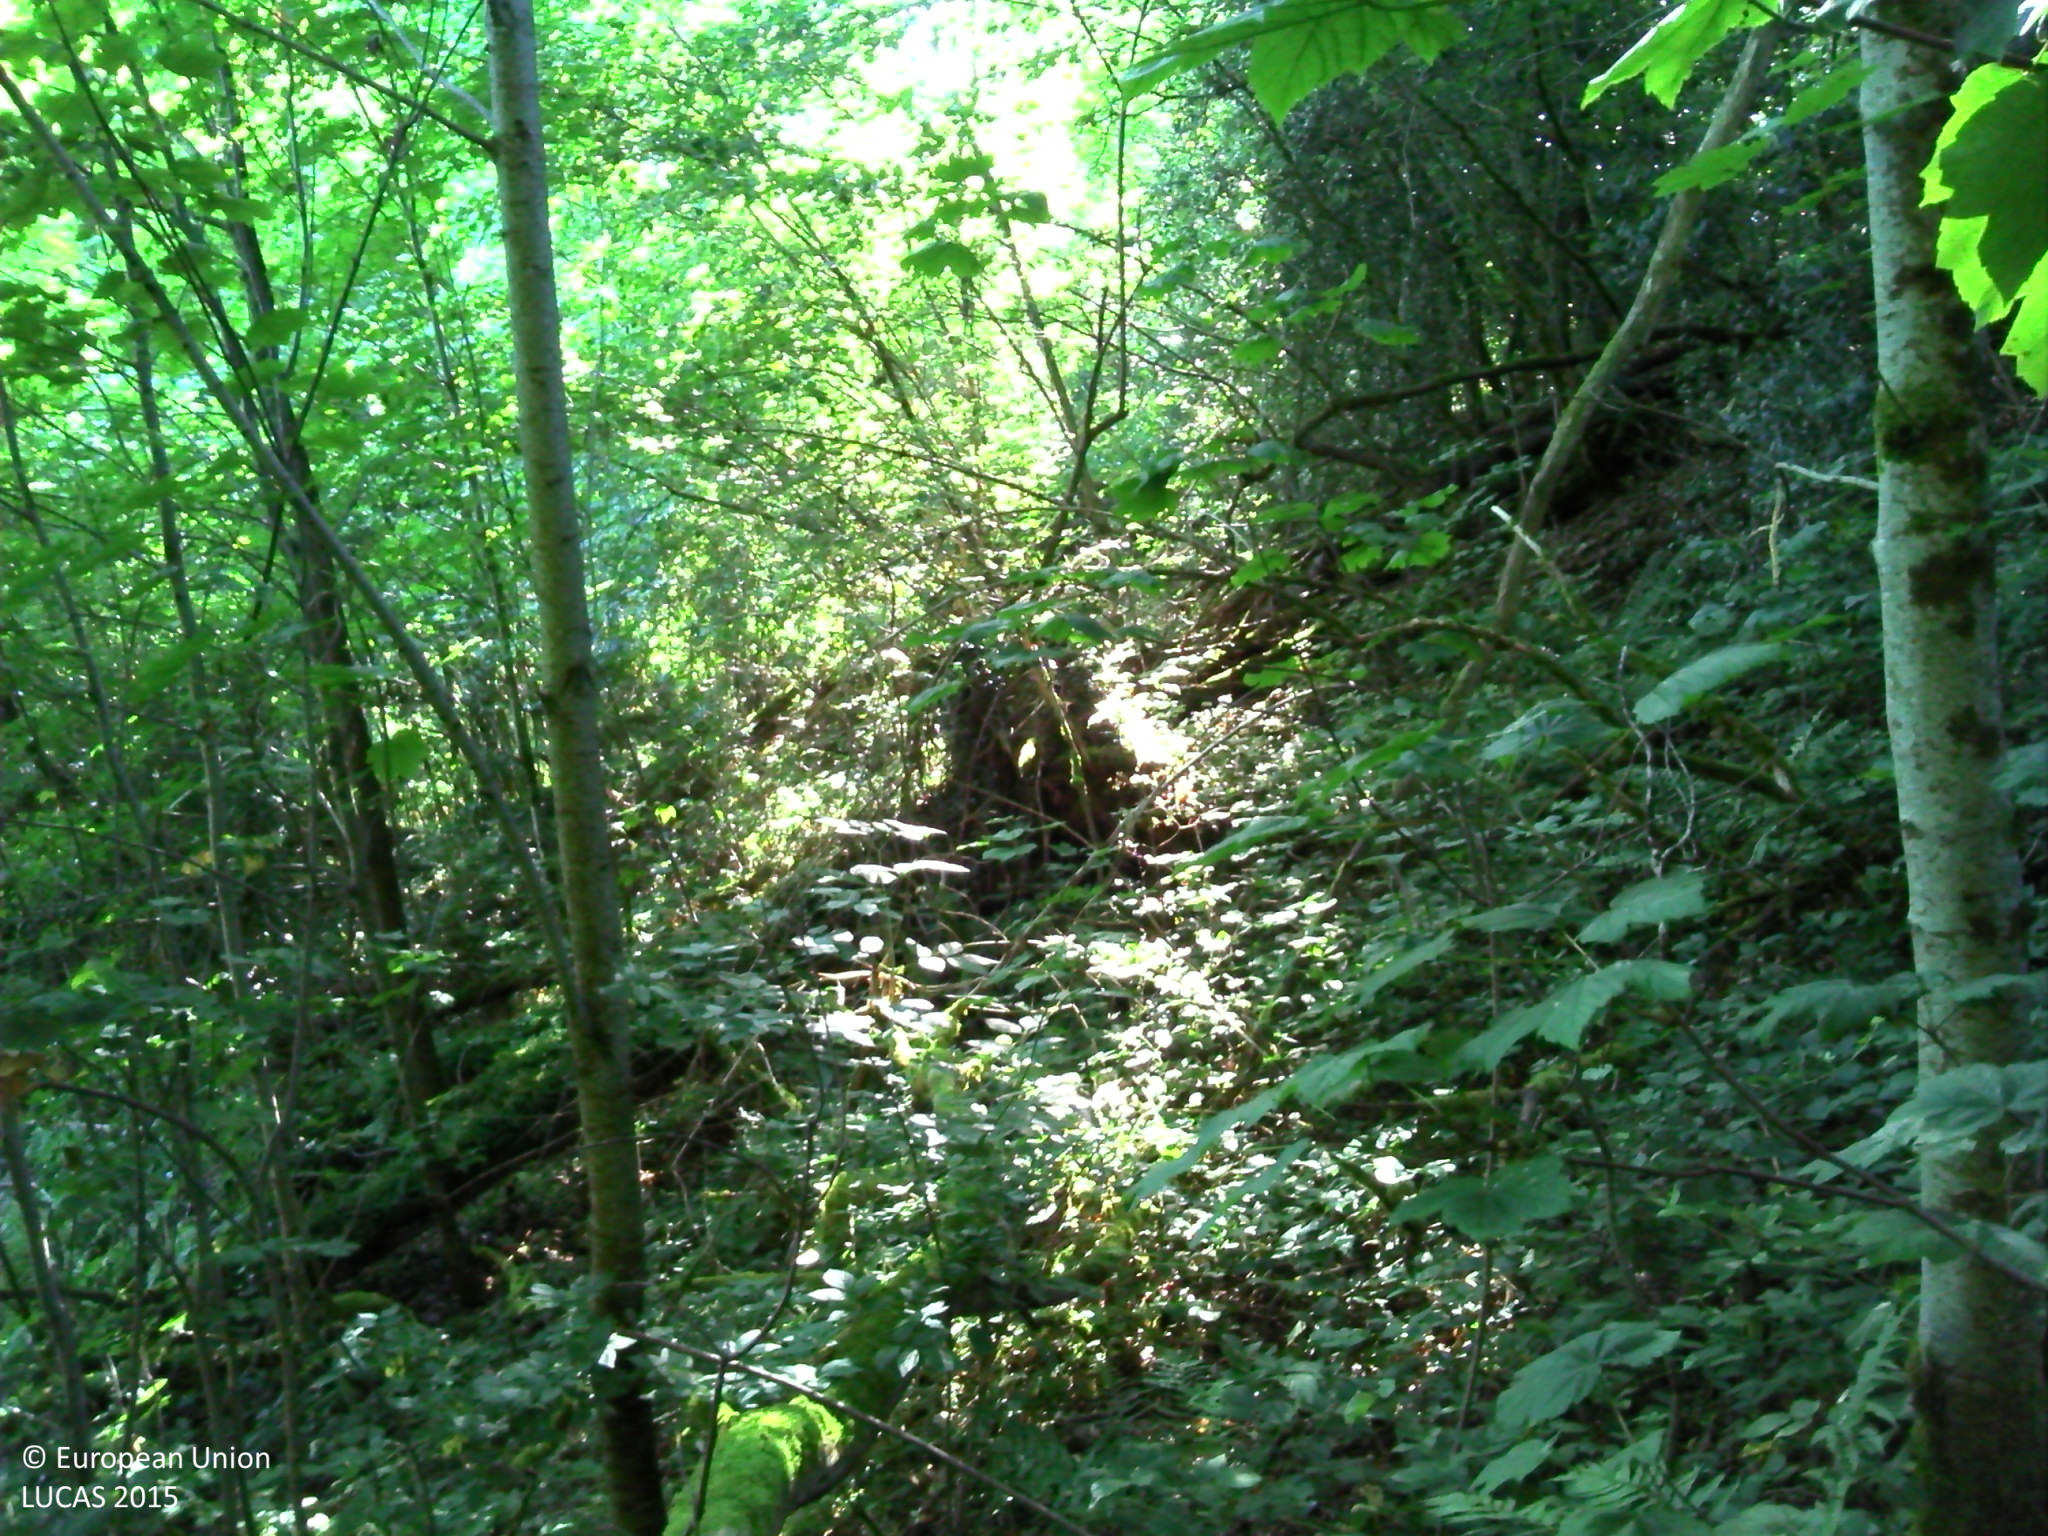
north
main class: Woodland
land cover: Broadleaved woodland
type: acidophilous oak and oak-birch forest
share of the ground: > 75 %
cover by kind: broadleaved forest trees 40 %, herbaceous plants 40 %, lichens and mosses 20 %
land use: Forestry
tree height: > 5 m
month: July
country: FR
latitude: 45.7409
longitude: 1.7297
